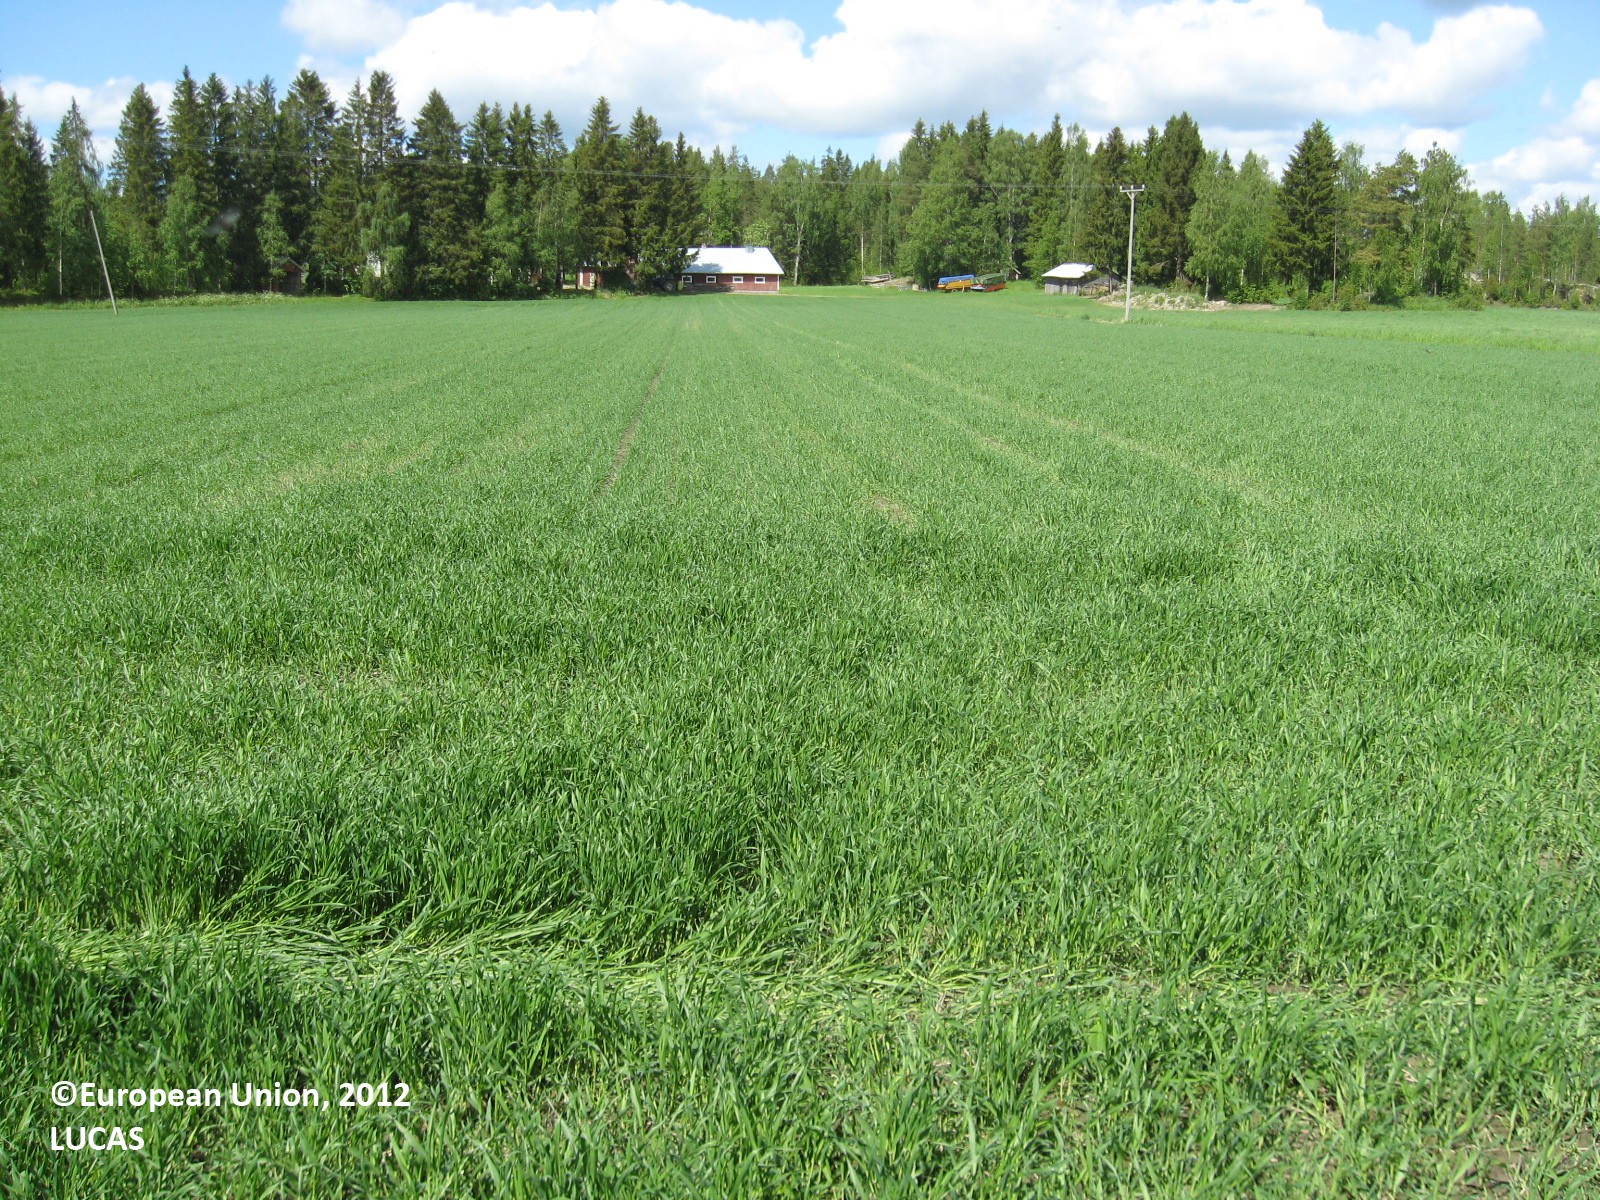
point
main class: Cropland
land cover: Barley
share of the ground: > 75 %
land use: Agriculture (excluding fallow land and kitchen gardens)
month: June
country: FI
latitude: 63.0467
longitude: 22.6501
